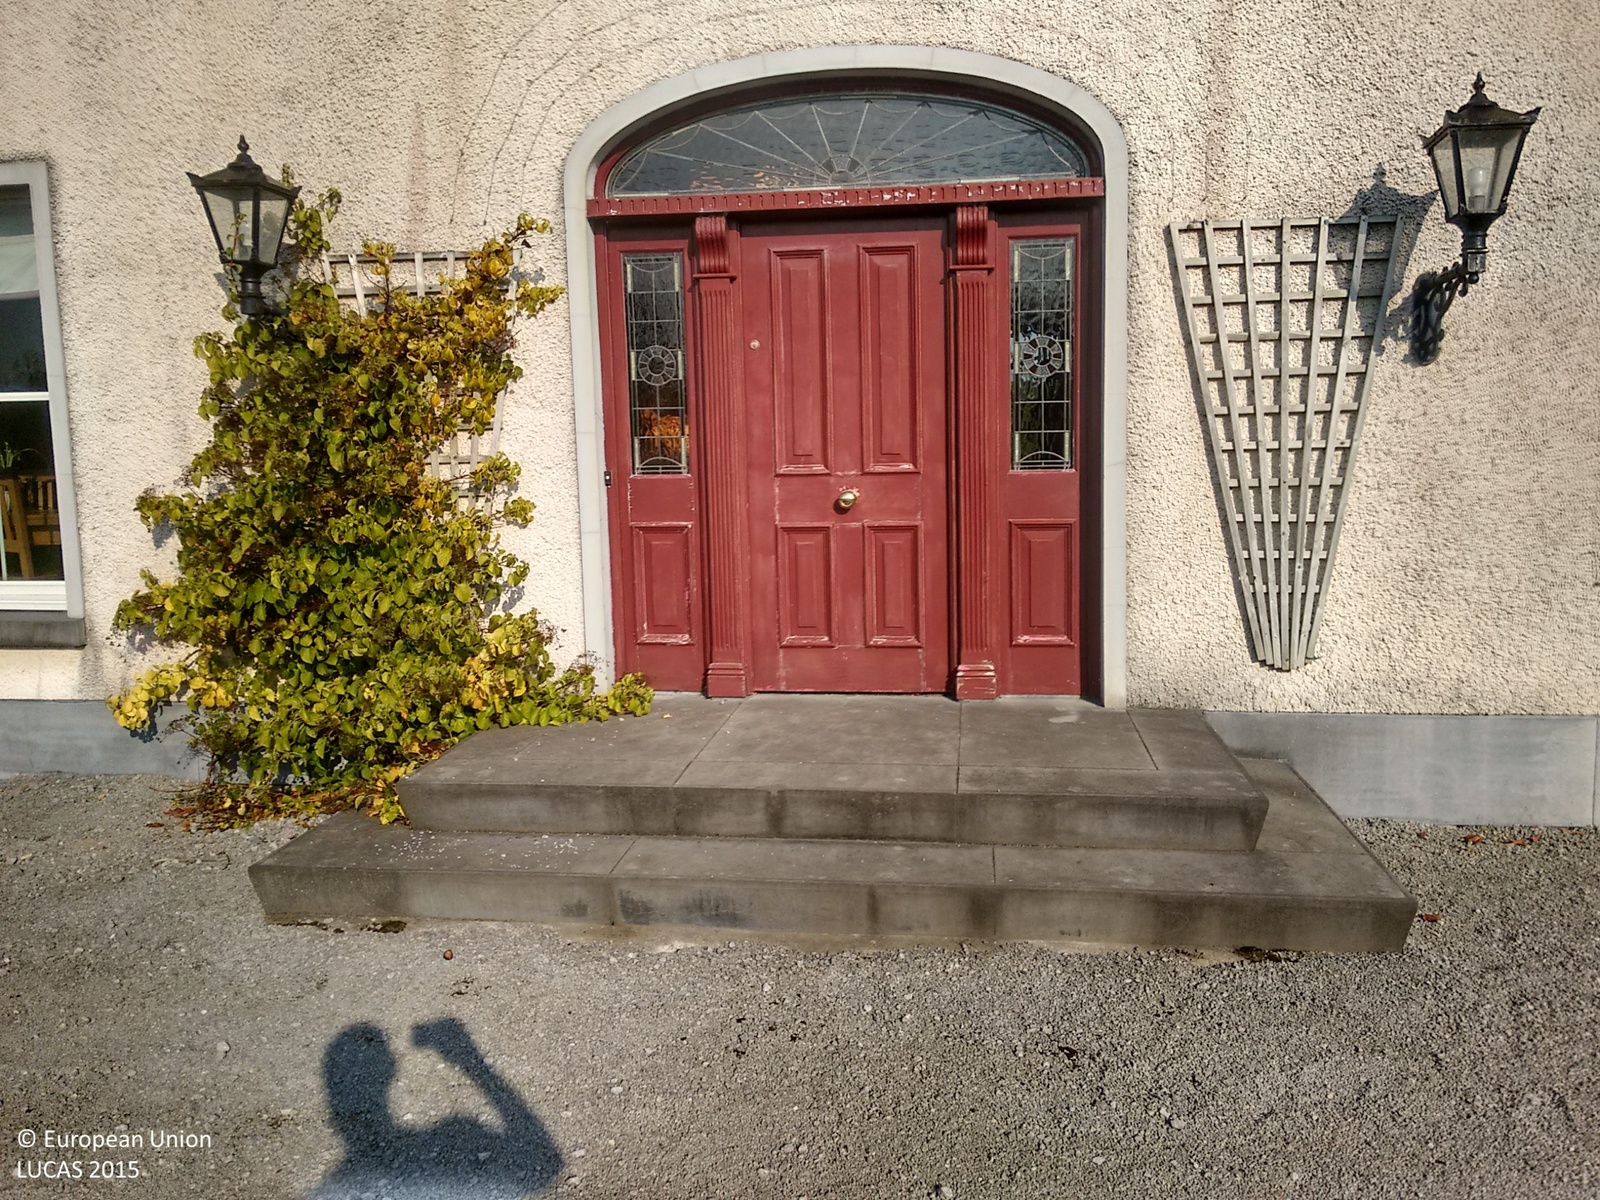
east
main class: Grassland
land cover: Grassland without tree/shrub cover
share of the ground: > 75 %
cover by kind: herbaceous plants 100 %
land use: Residential
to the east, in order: Grassland without tree/shrub cover; Grassland with sparse tree/shrub cover; Managed hedges; Grassland without tree/shrub cover; Abandoned hedges; Grassland without tree/shrub cover
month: October
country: IE
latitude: 52.4355
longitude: -9.0885
